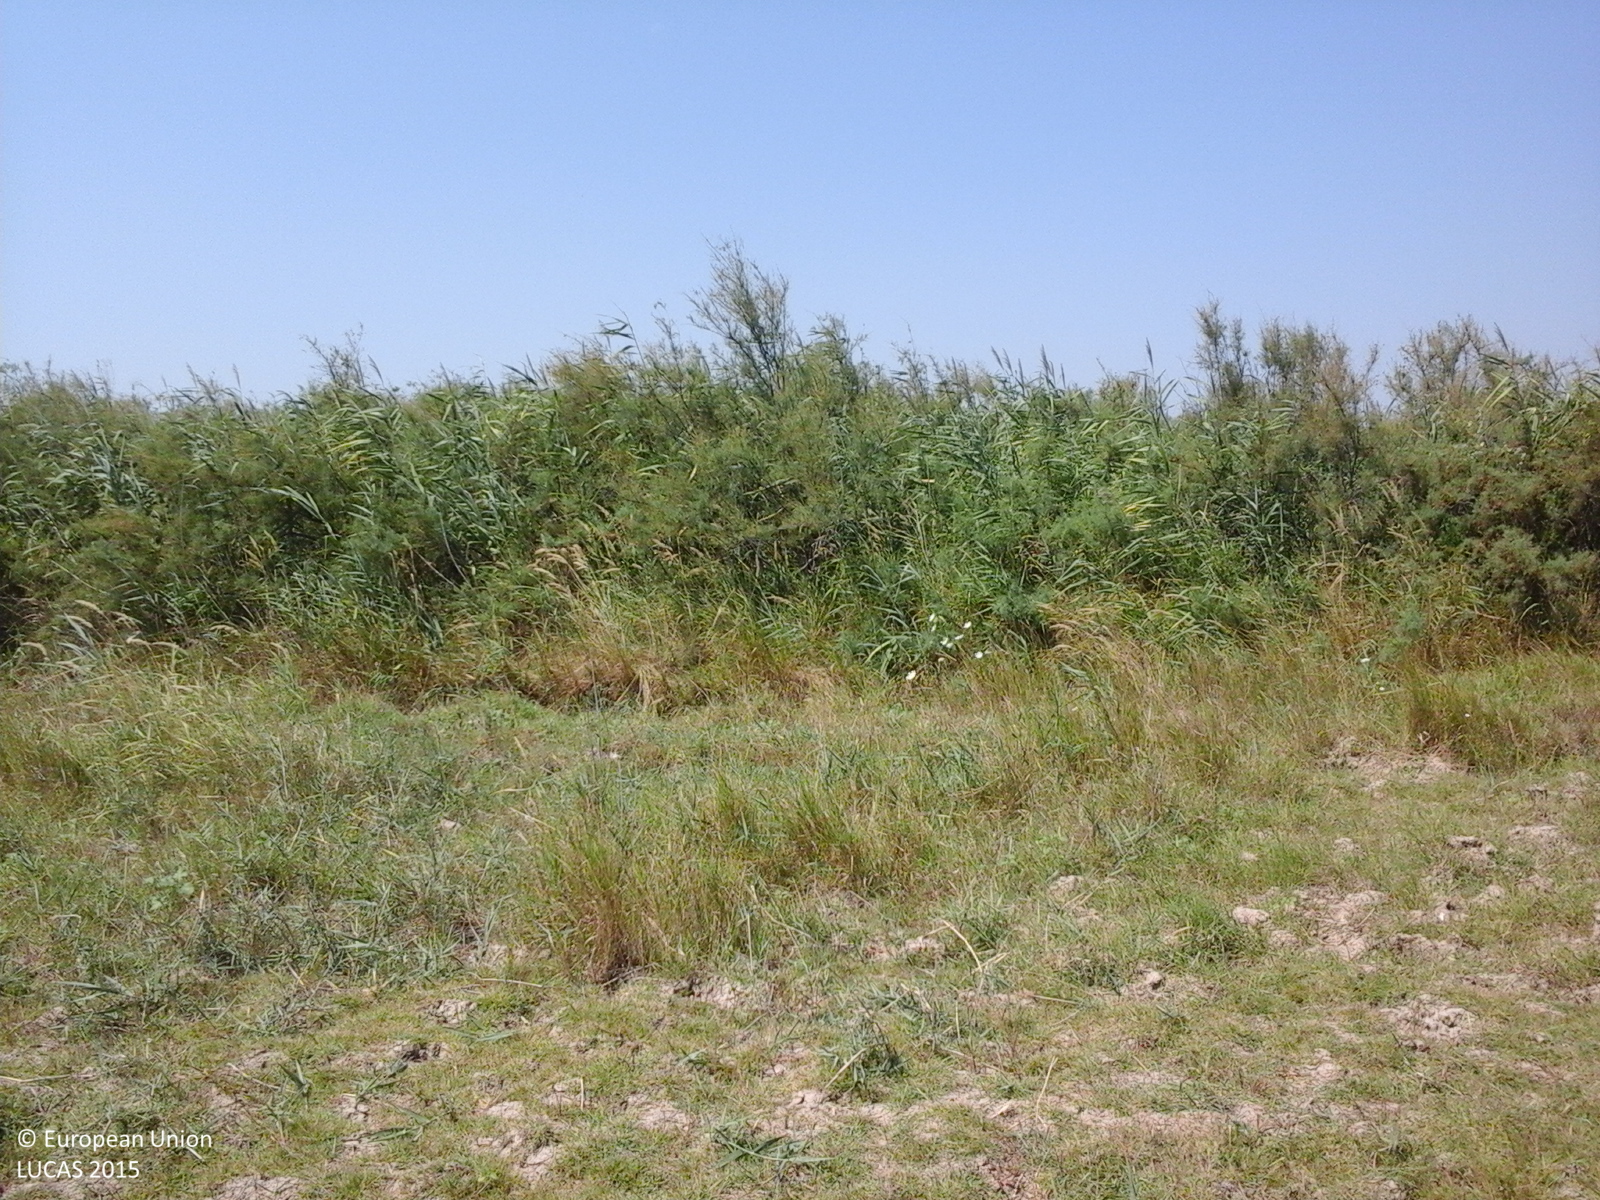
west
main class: Grassland
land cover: Spontaneously vegetated surfaces
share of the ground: > 75 %
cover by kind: herbaceous plants 100 %
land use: Agriculture (excluding fallow land and kitchen gardens)
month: August
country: RO
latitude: 45.2098
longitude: 27.3738
